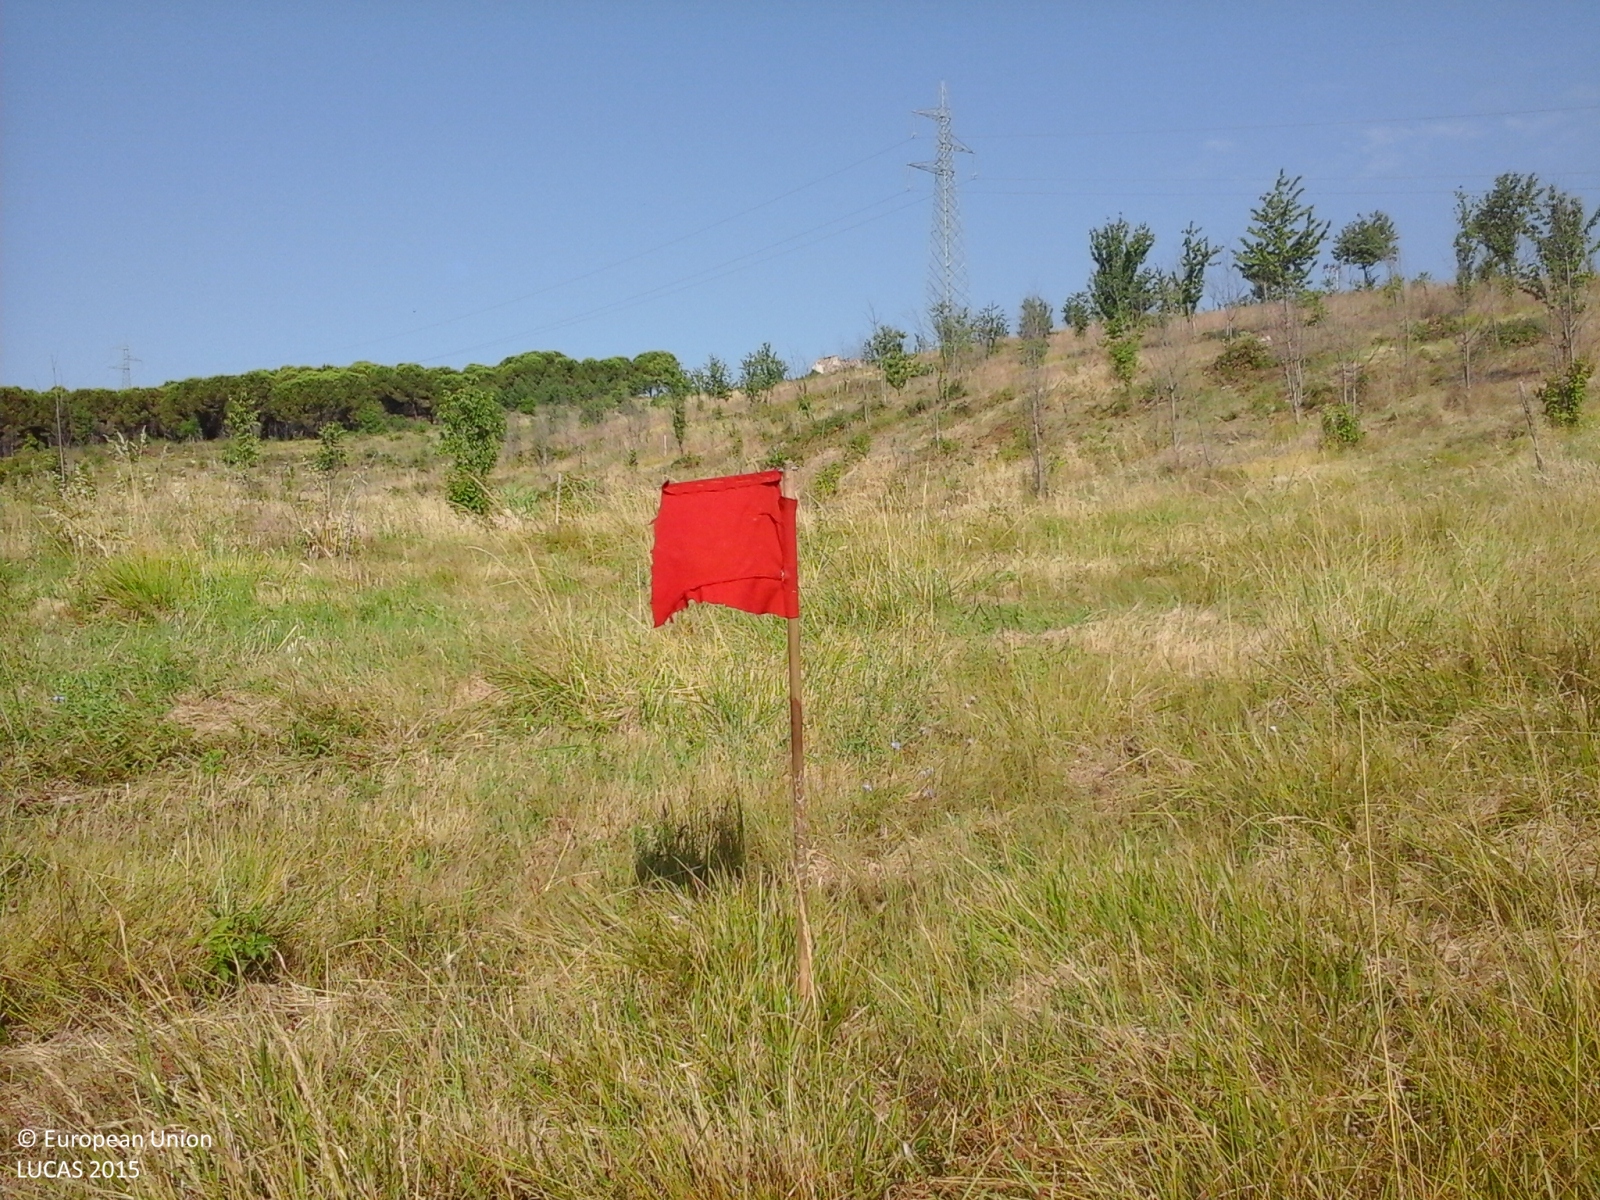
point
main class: Cropland
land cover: Nuts trees
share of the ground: 25 - 50 %
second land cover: Grassland without tree/shrub cover
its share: > 75 %
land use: Agriculture (excluding fallow land and kitchen gardens)
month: July
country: IT
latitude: 41.0977
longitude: 14.6849
